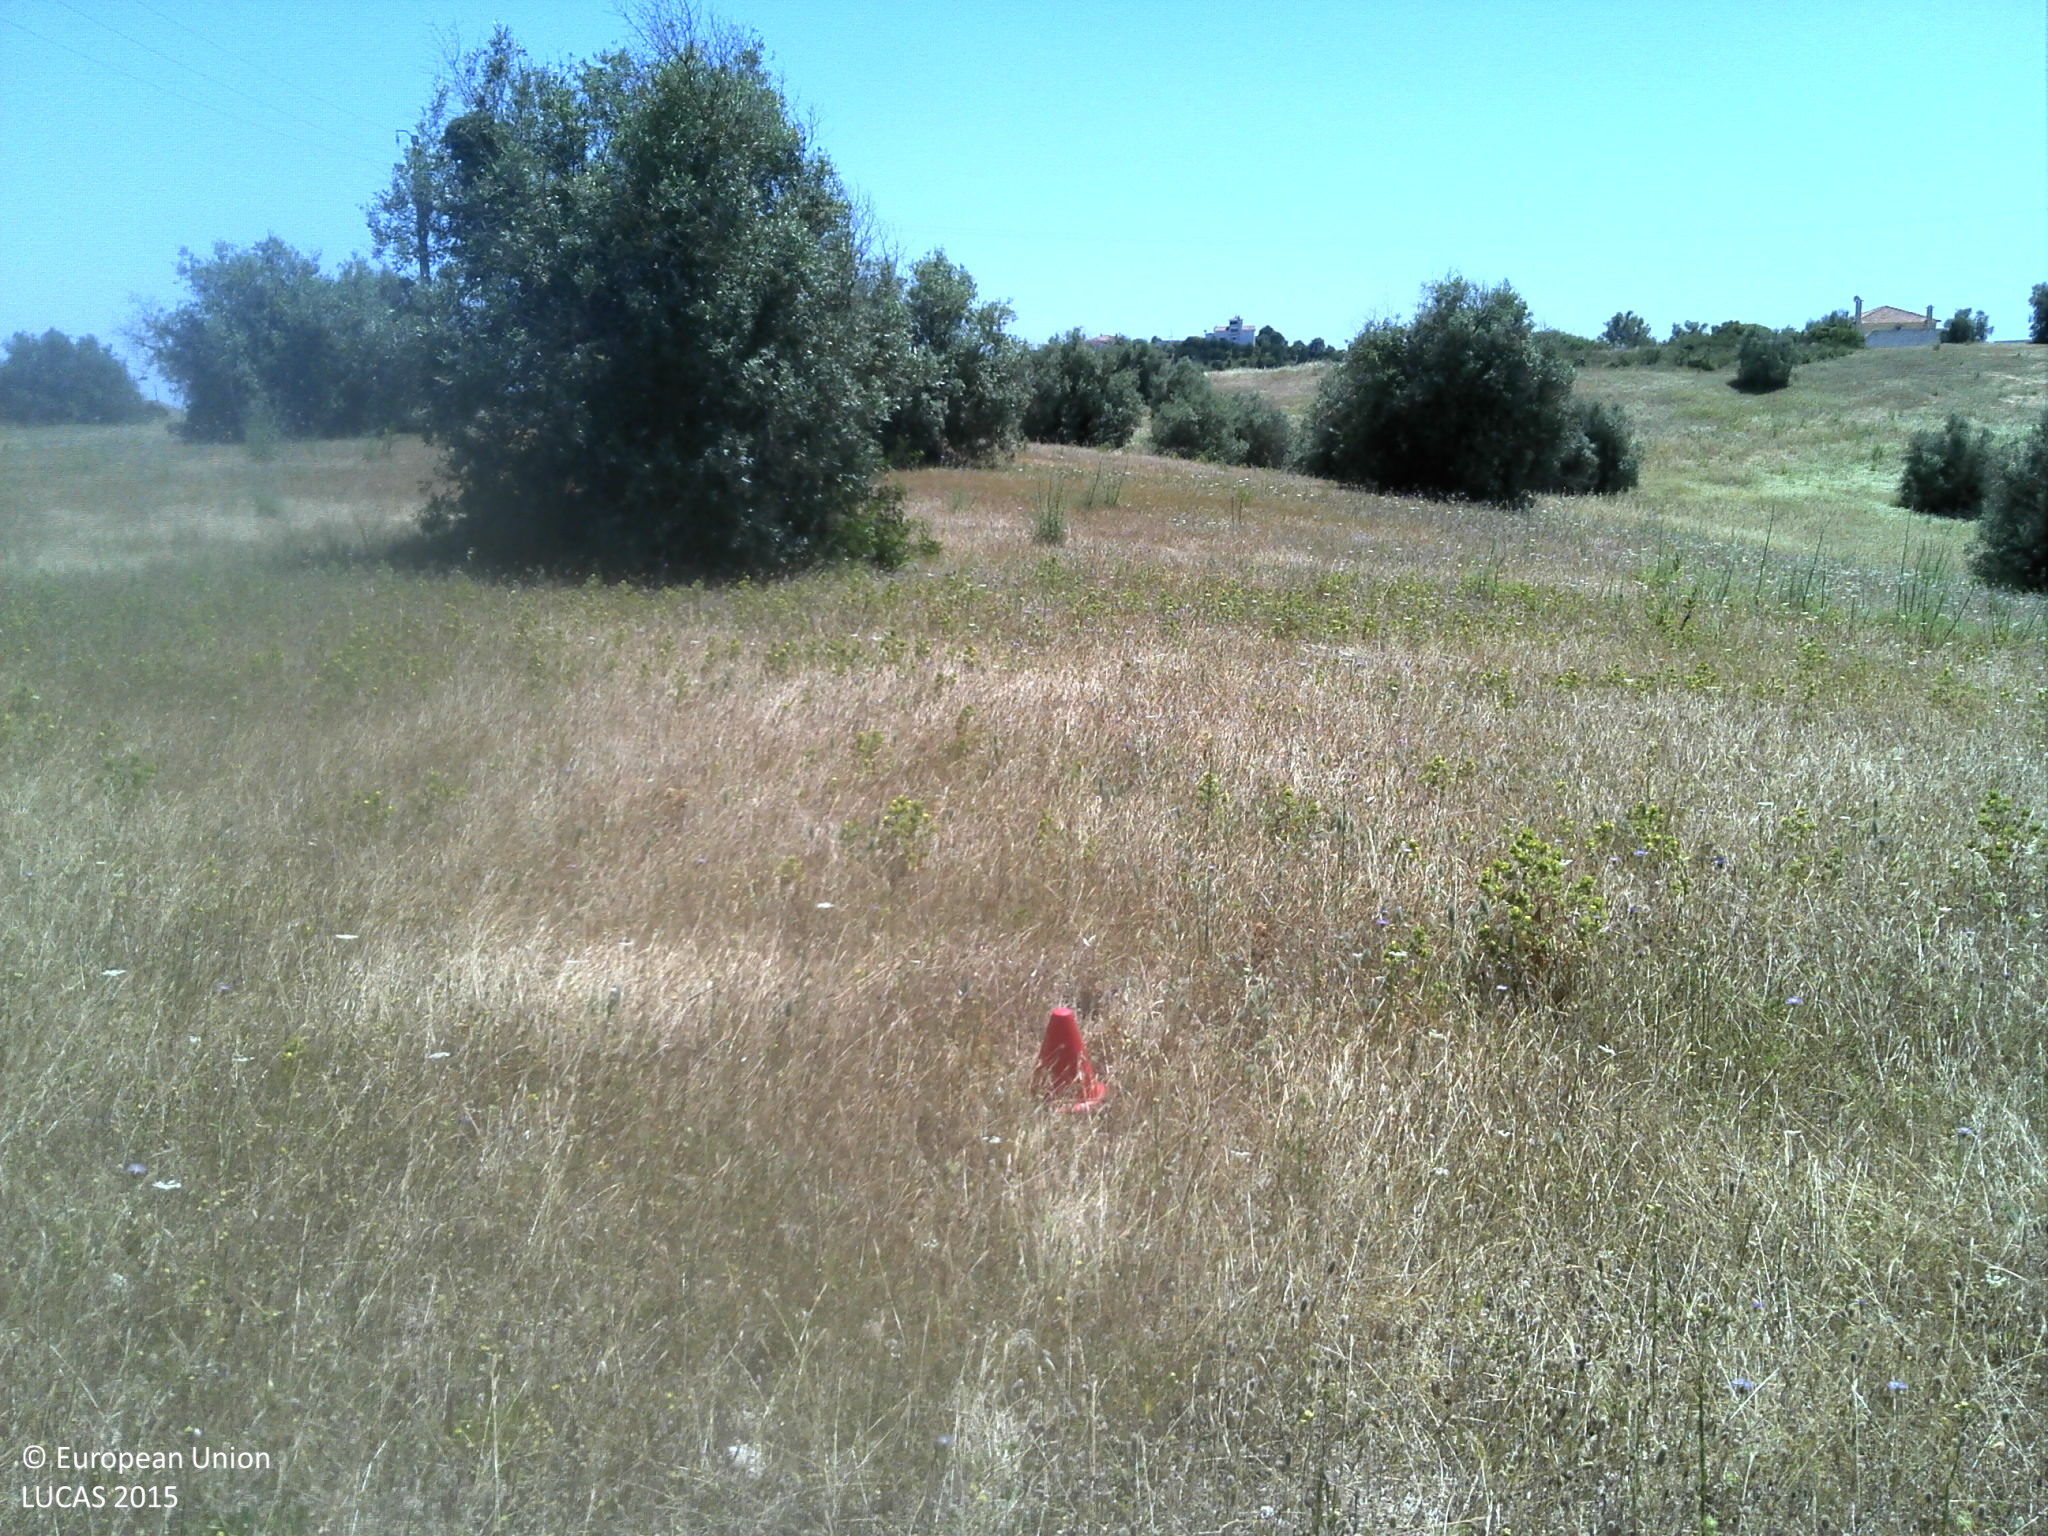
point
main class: Cropland
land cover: Olive groves
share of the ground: 10 - 25 %
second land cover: Grassland without tree/shrub cover
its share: 50 - 75 %
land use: Agriculture (excluding fallow land and kitchen gardens)
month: May
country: PT
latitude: 39.2876
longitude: -8.7769
